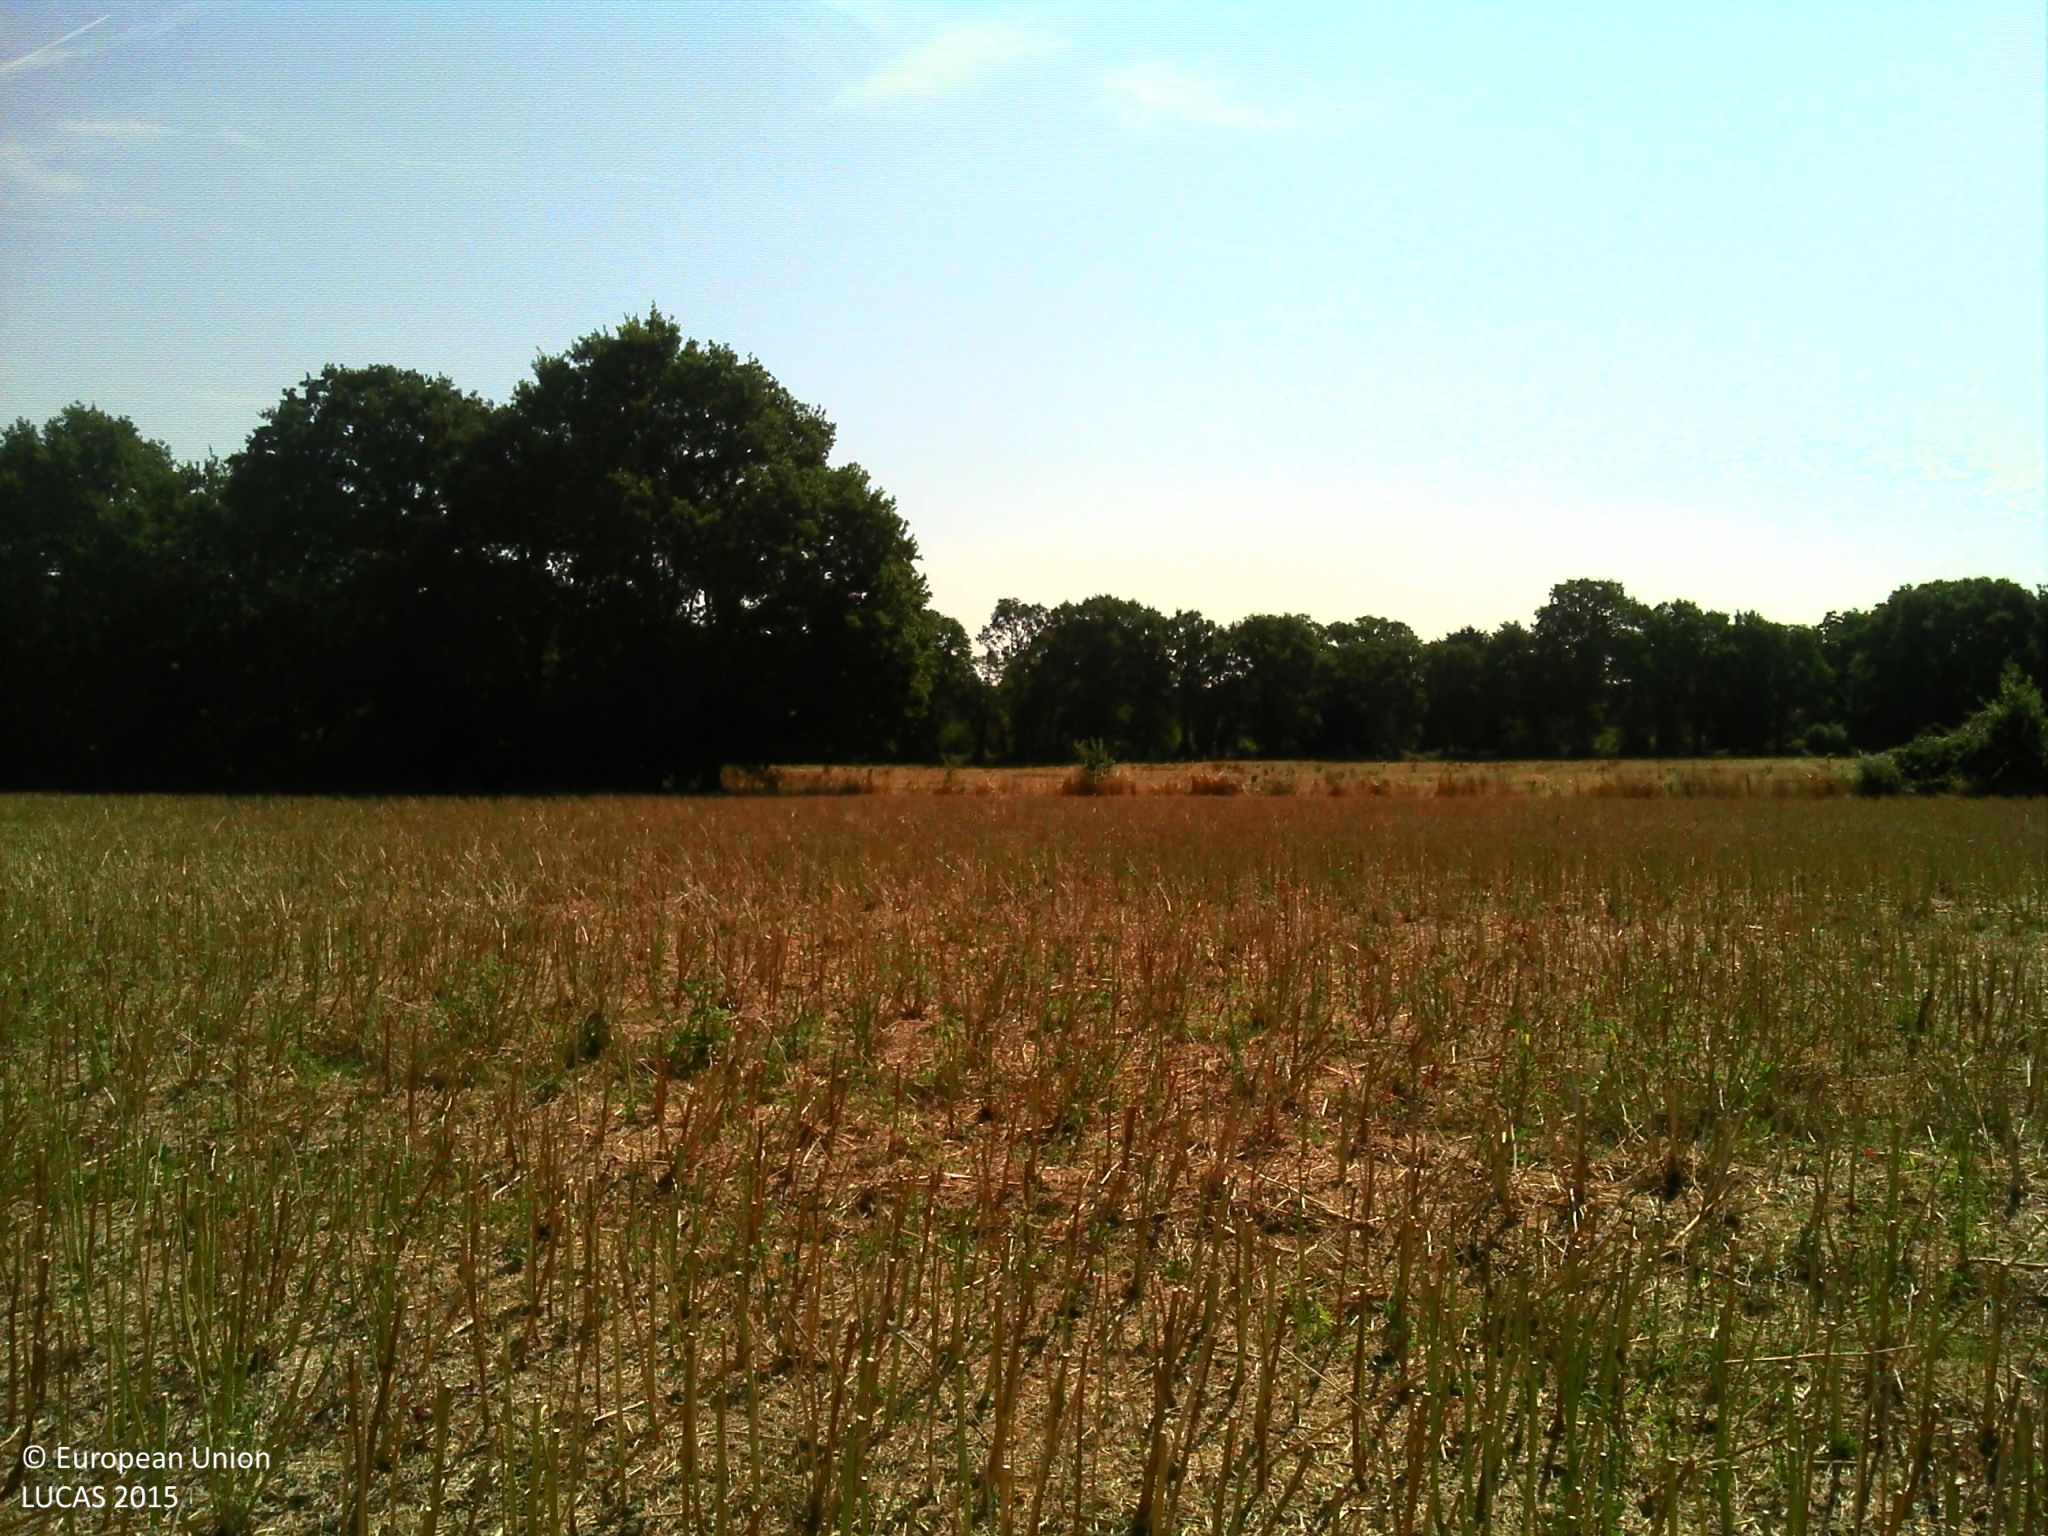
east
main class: Cropland
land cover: Rape and turnip rape
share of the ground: 25 - 50 %
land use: Agriculture (excluding fallow land and kitchen gardens)
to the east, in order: Rape and turnip rape; Ditches and canals; Lines of trees; Fences; Grassland without tree/shrub cover
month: August
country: FR
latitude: 47.9175
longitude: -1.0790
